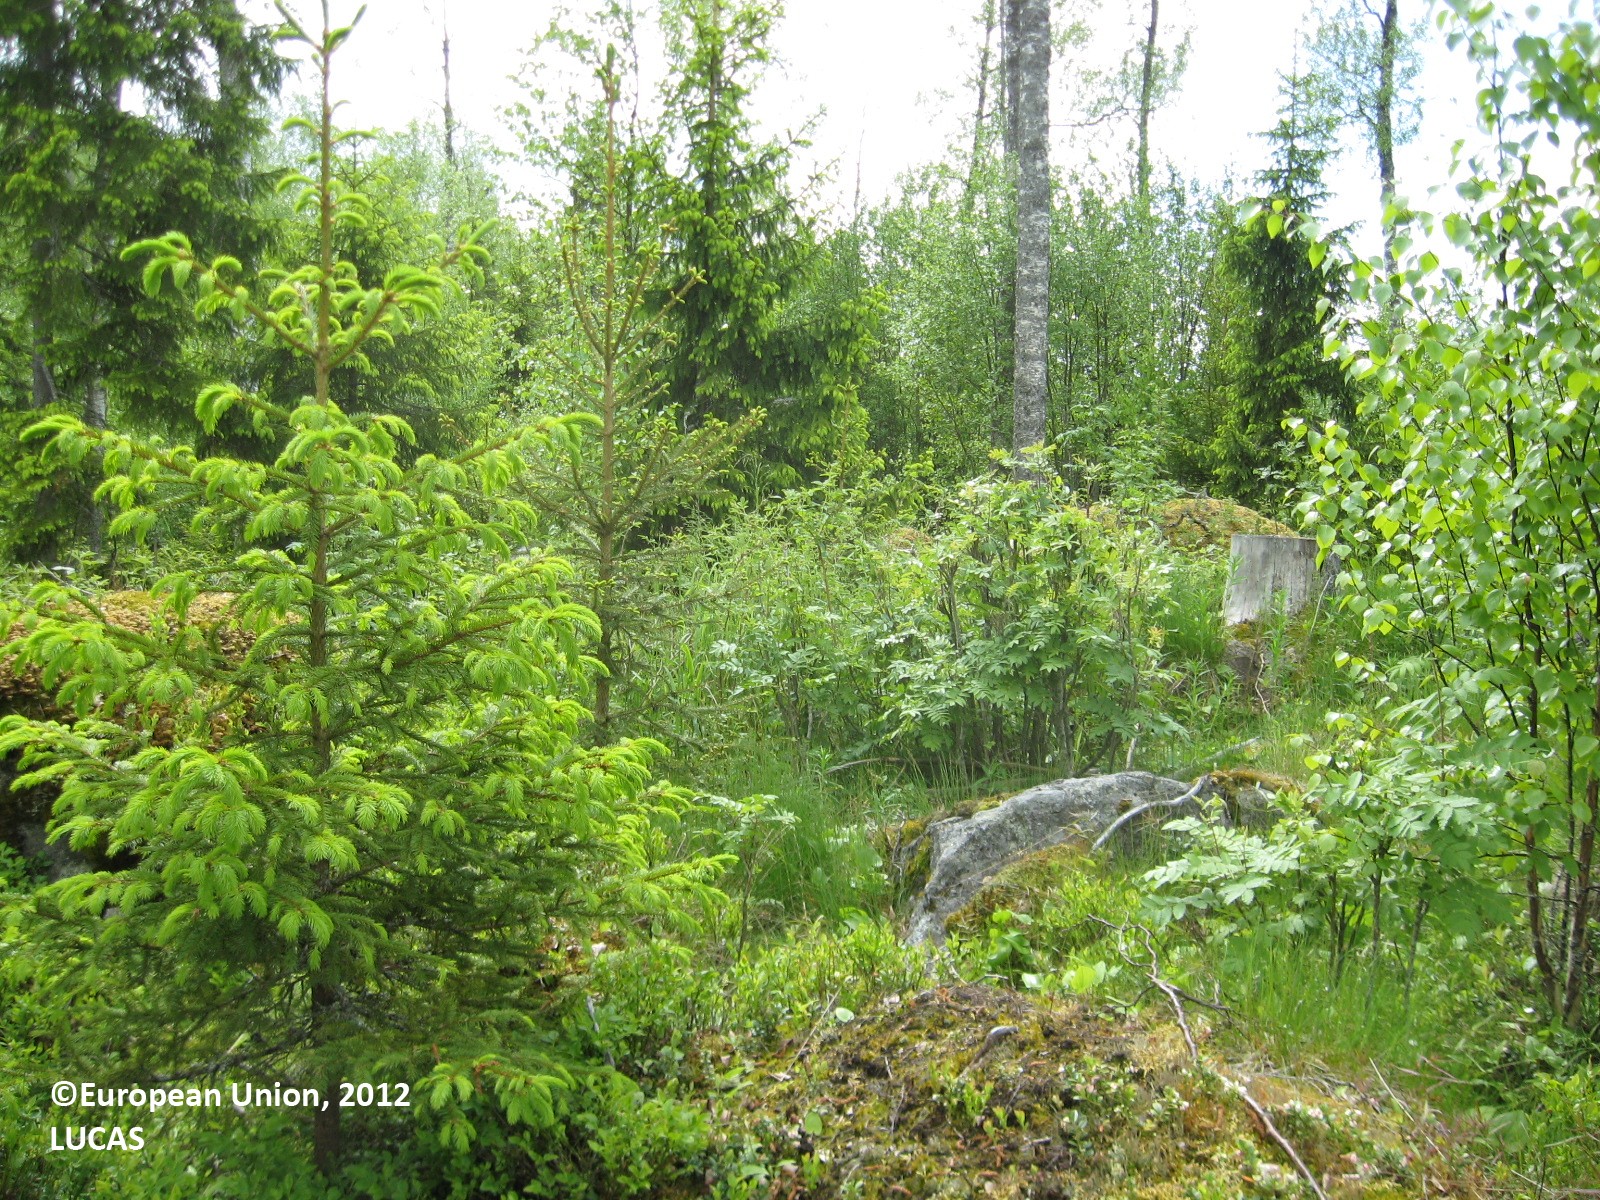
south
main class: Woodland
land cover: Spruce dominated mixed woodland
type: boreal forest
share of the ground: > 75 %
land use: Forestry
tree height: > 5 m
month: June
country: FI
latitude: 63.0562
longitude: 21.8527
